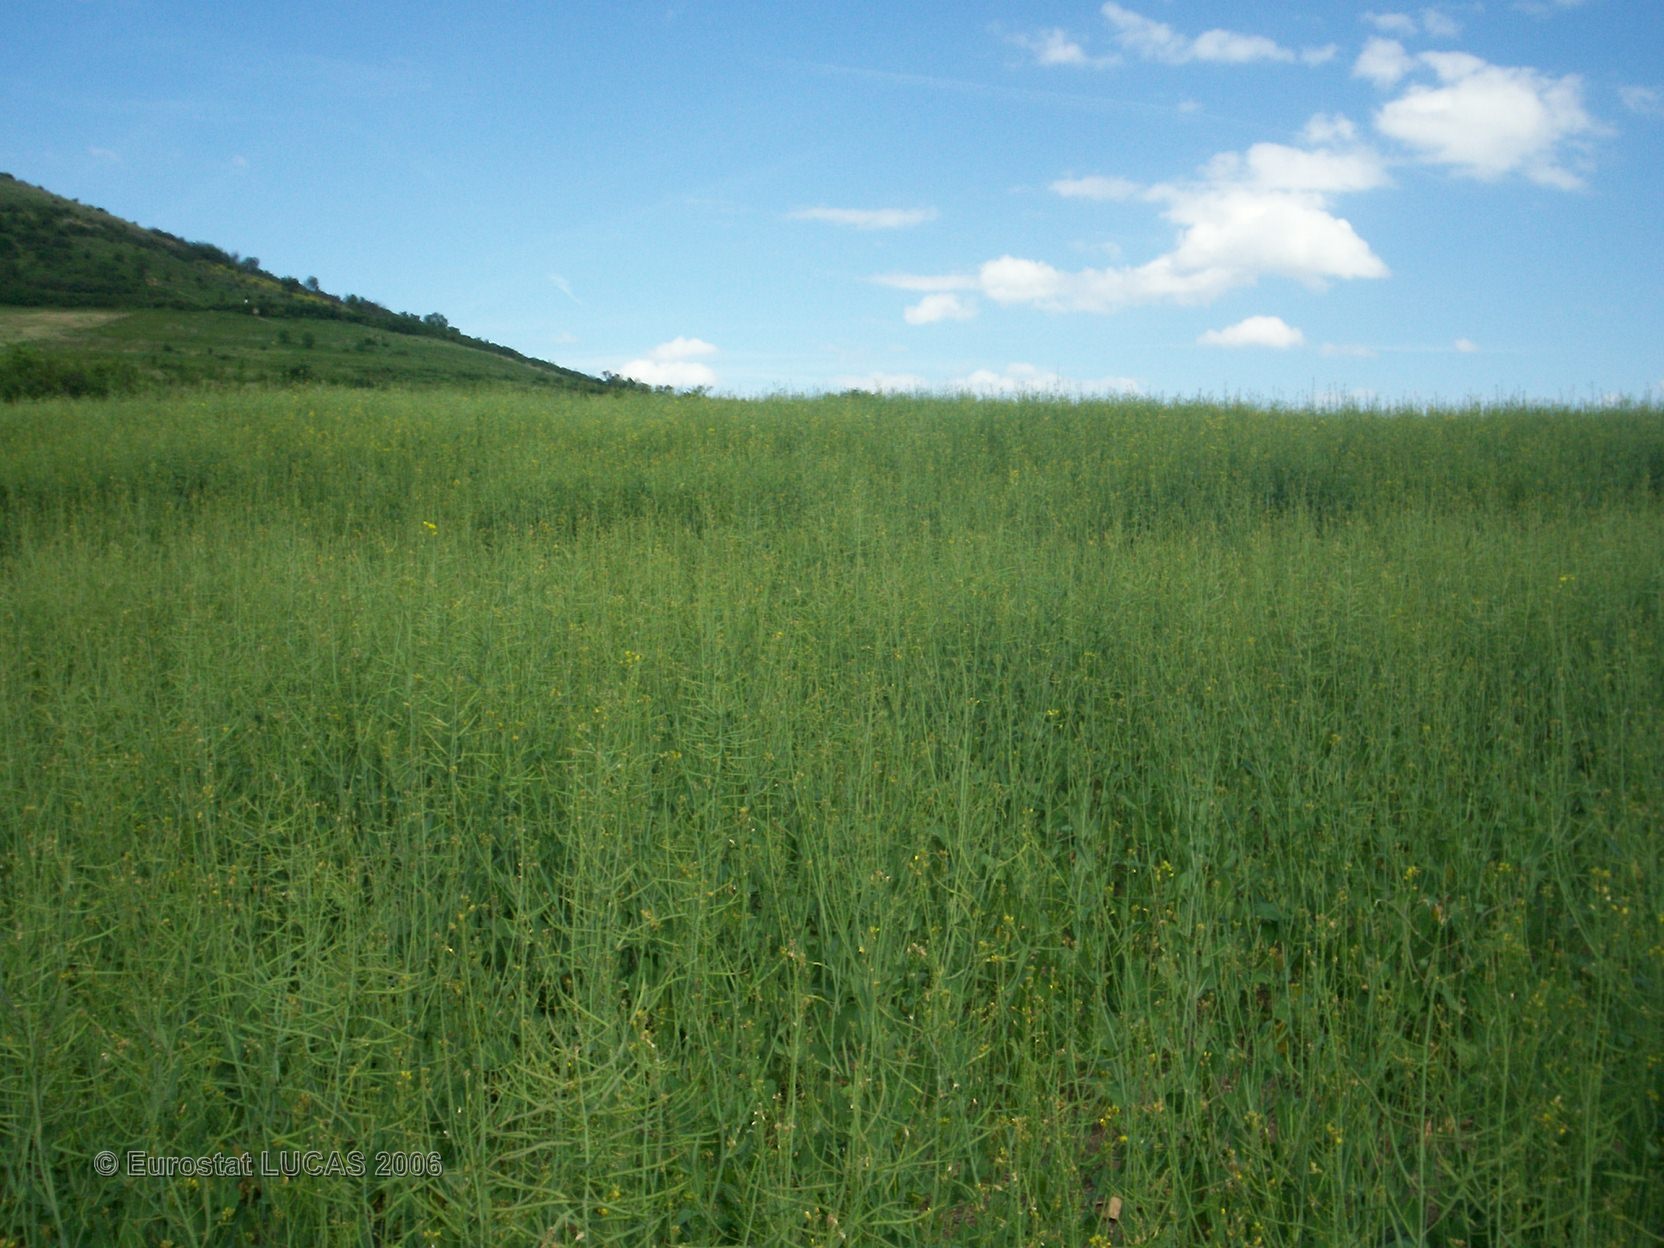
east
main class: Cropland
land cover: Rape and turnip rape
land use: Agriculture (excluding fallow land and kitchen gardens)
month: May
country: FR
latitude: 45.7535
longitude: 3.1738
